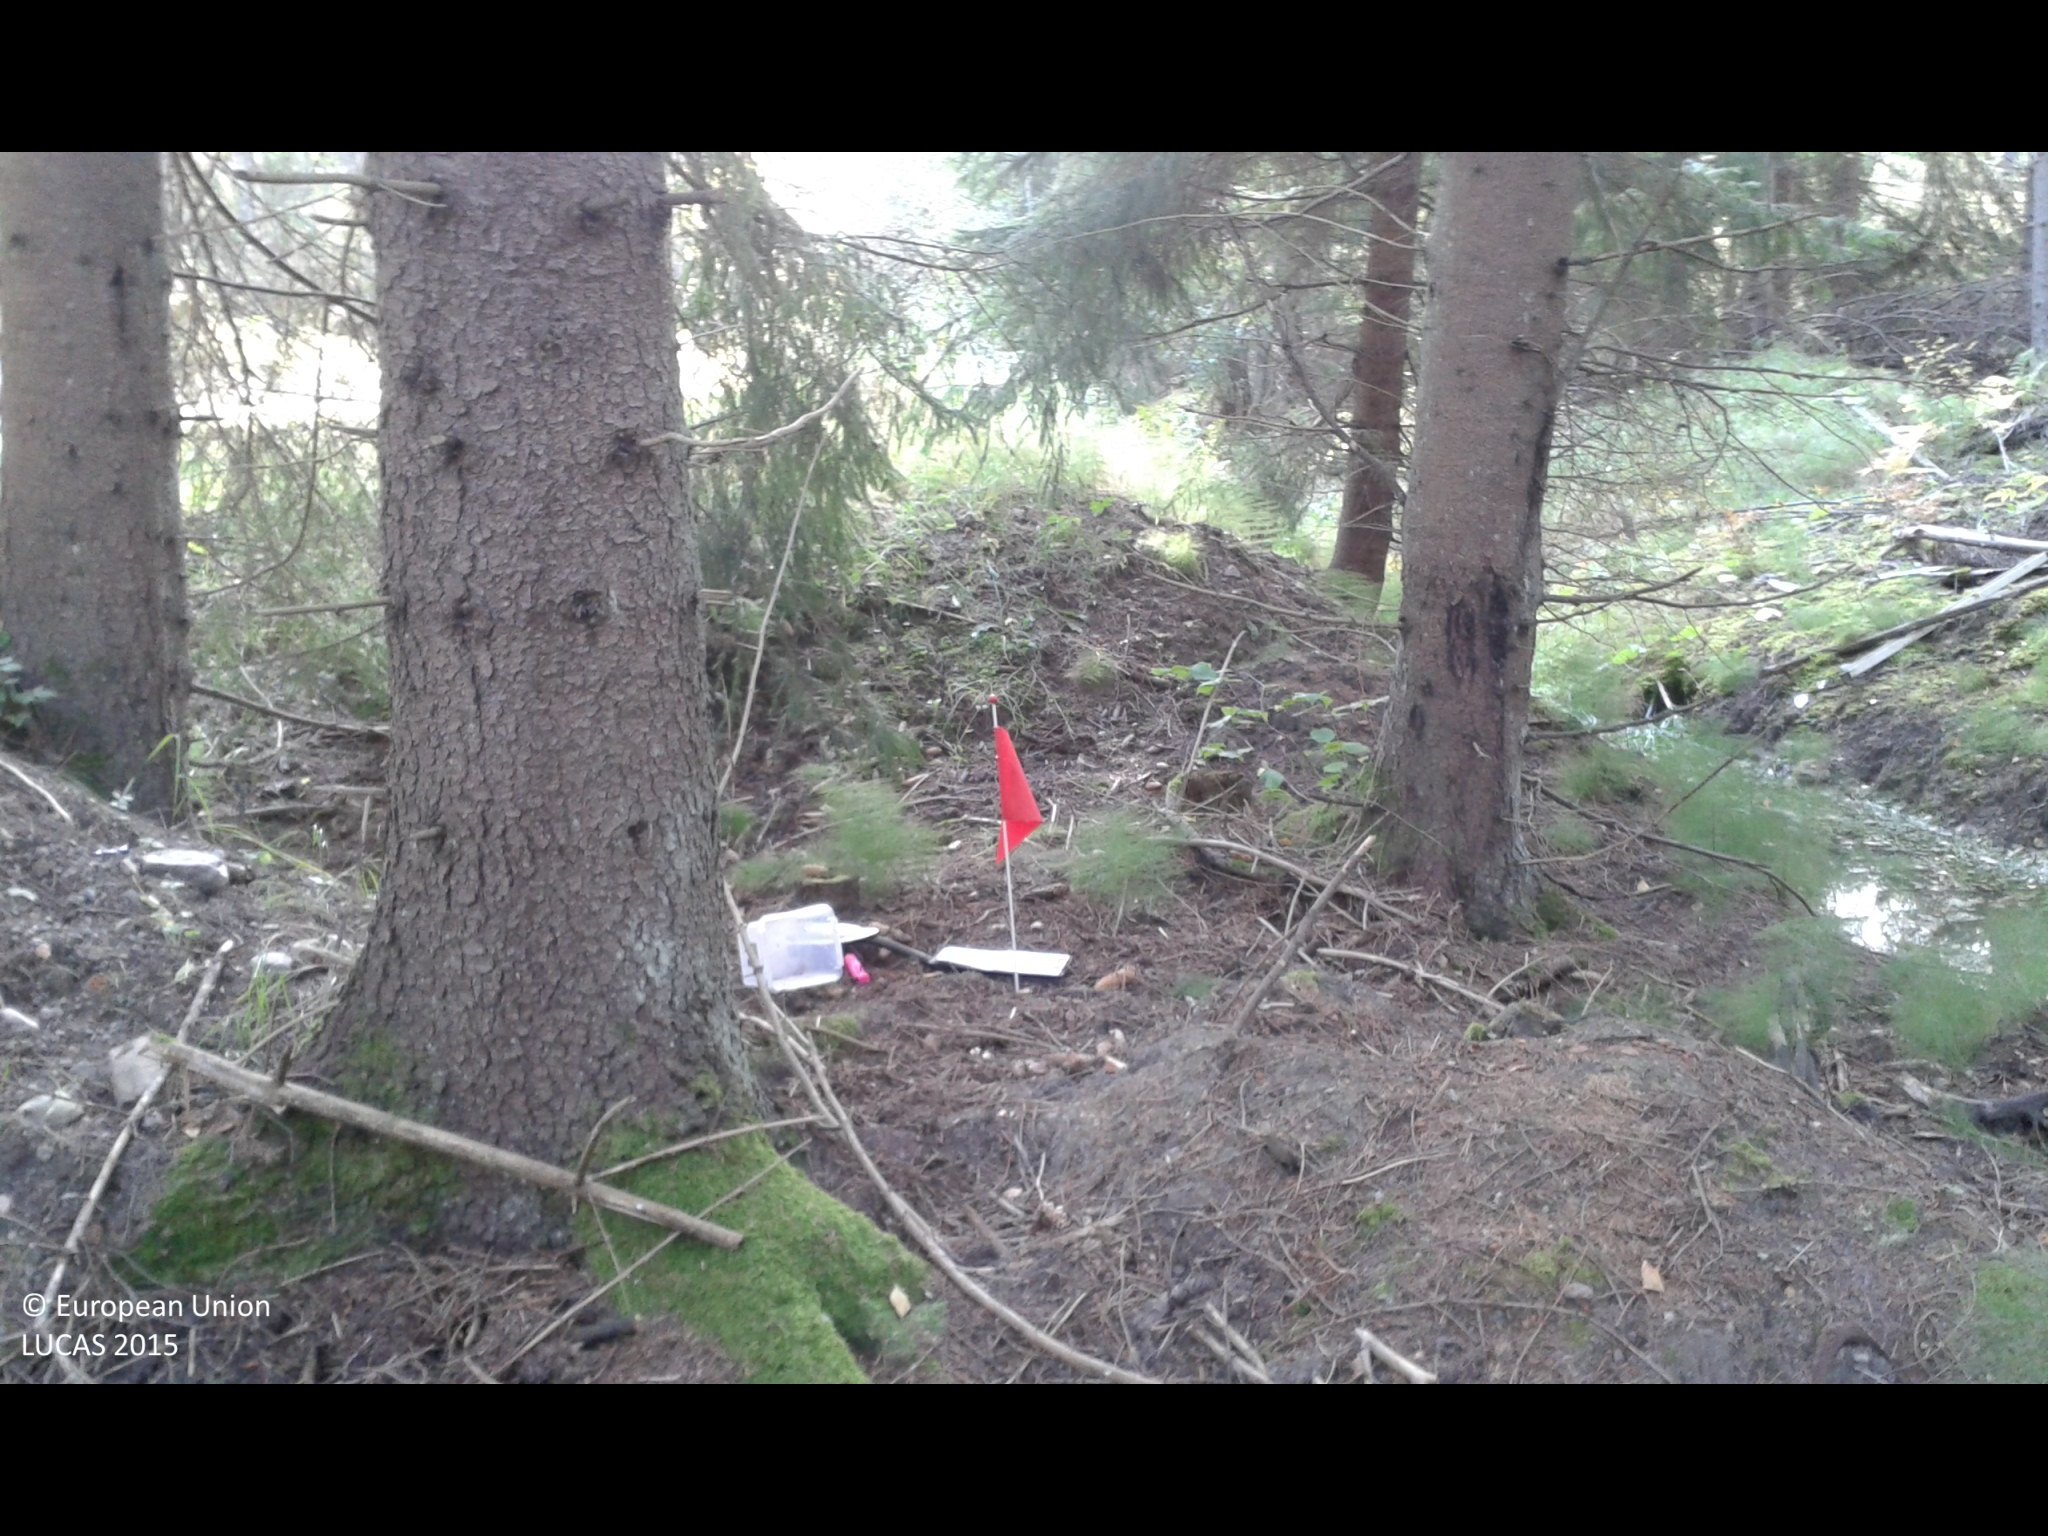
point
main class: Woodland
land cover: Spruce dominated coniferous woodland
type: boreal forest
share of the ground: > 75 %
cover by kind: coniferous forest trees 80 %, herbaceous plants 20 %
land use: Forestry
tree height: > 5 m
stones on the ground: < 10 %
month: October
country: SE
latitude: 58.9704
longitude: 17.4589
